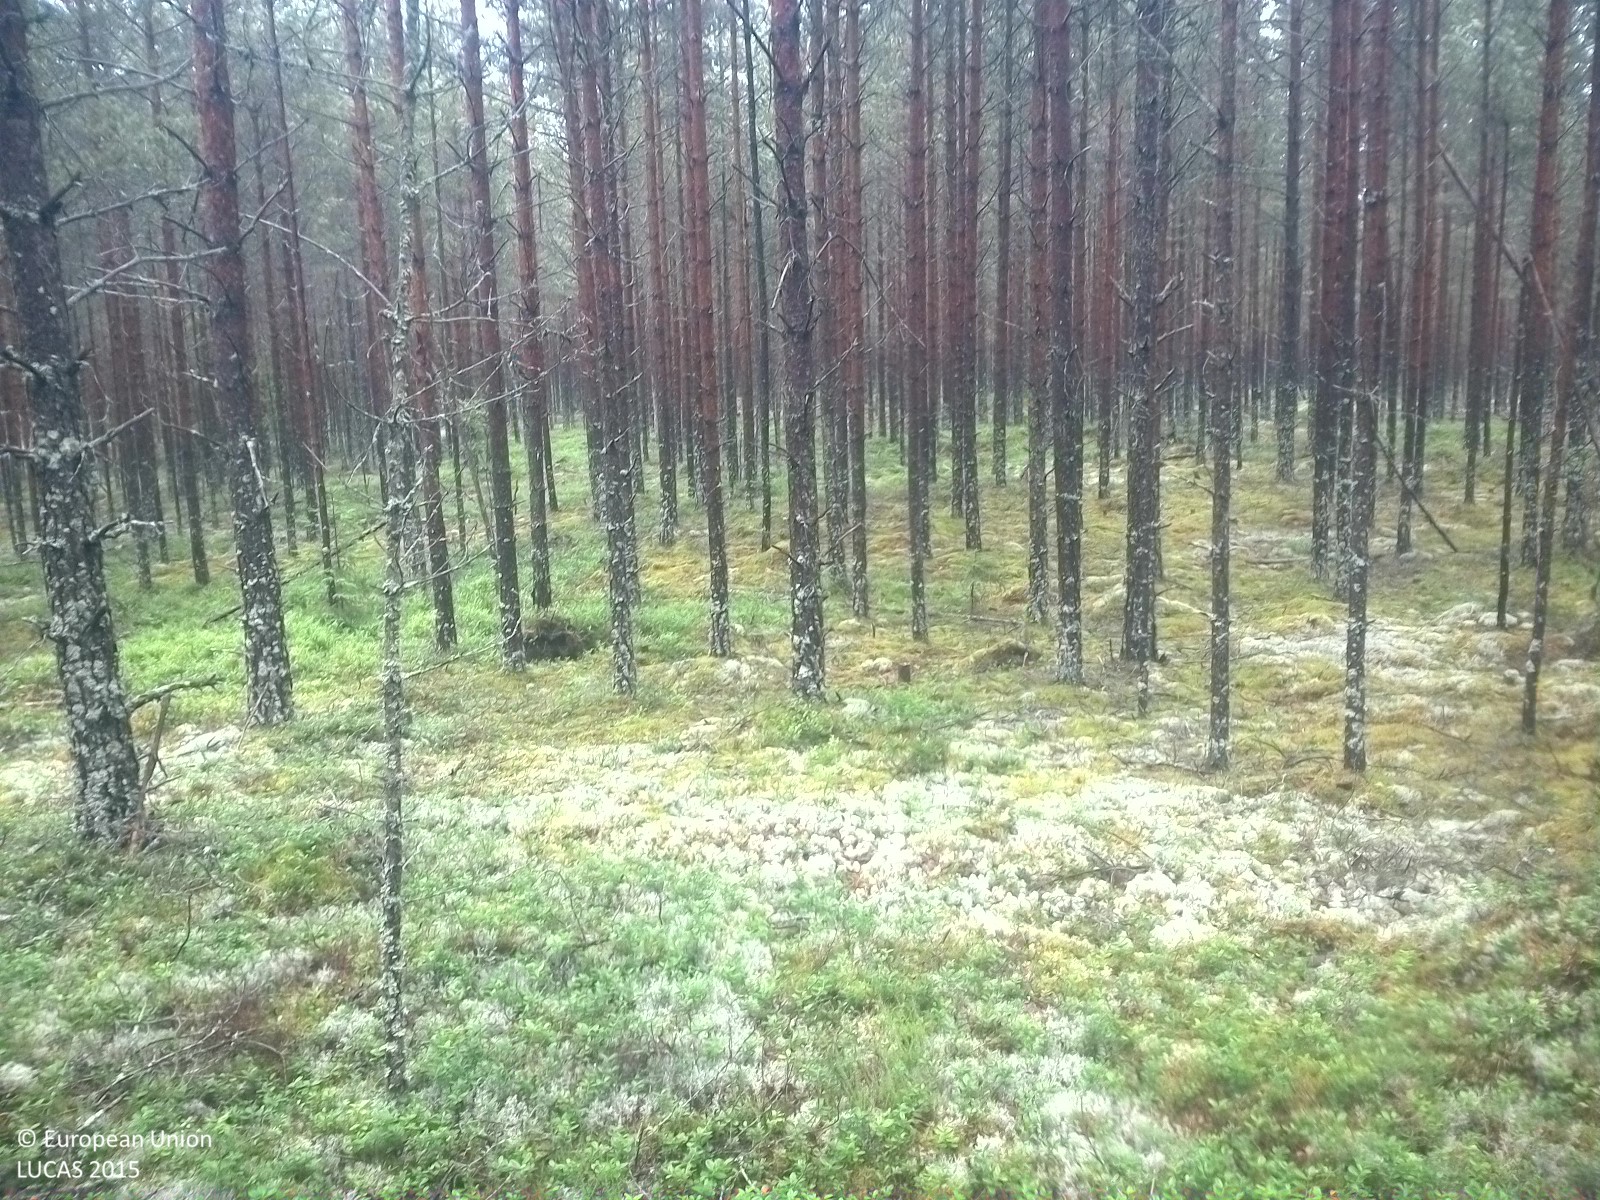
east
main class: Woodland
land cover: Pine dominated coniferous woodland
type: boreal forest
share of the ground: 25 - 50 %
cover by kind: coniferous forest trees 40 %, lichens and mosses 30 %, herbaceous plants 20 %, shrubs 10 %
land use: Forestry
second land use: Amenities, museums, leisure
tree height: > 5 m
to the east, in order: Pine dominated coniferous woodland; Tracks; Pine dominated coniferous woodland
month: July
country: SE
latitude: 58.9168
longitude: 15.0807
